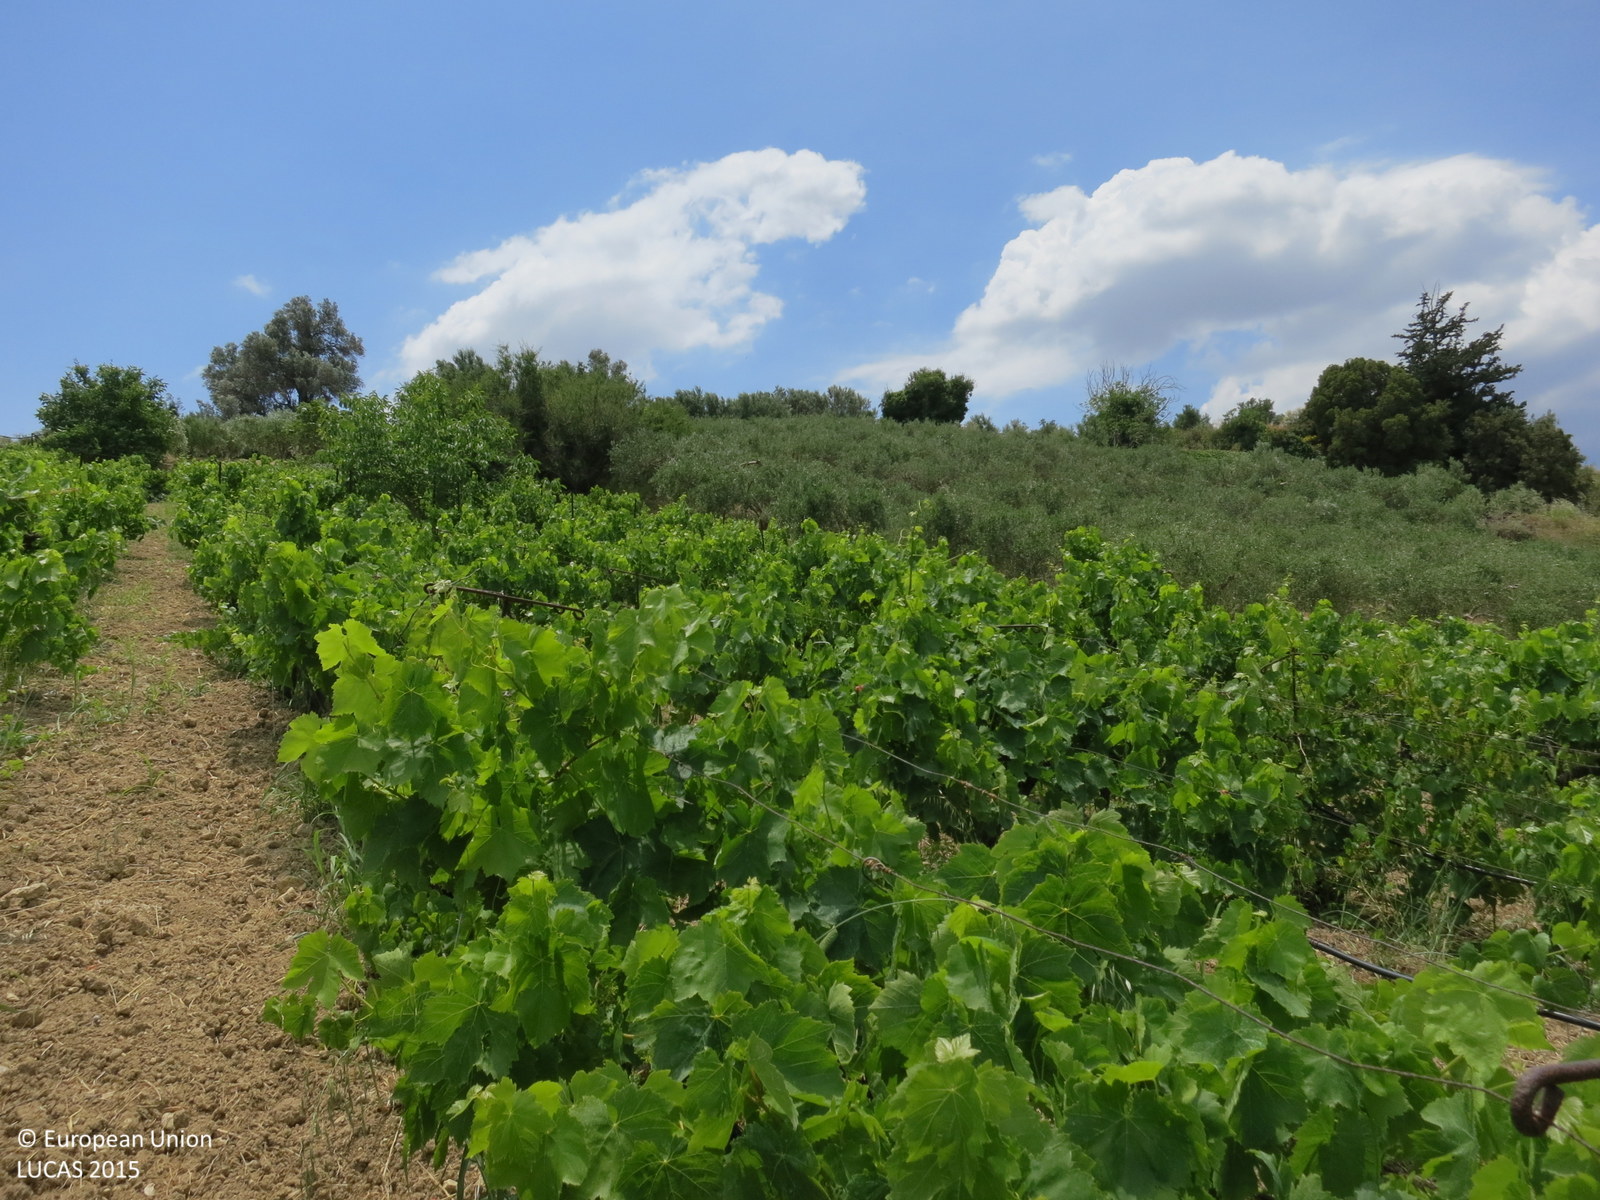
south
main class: Cropland
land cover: Vineyards
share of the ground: > 75 %
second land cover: Other bare soil
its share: > 75 %
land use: Agriculture (excluding fallow land and kitchen gardens)
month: June
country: GR
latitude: 35.2581
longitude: 25.0157
